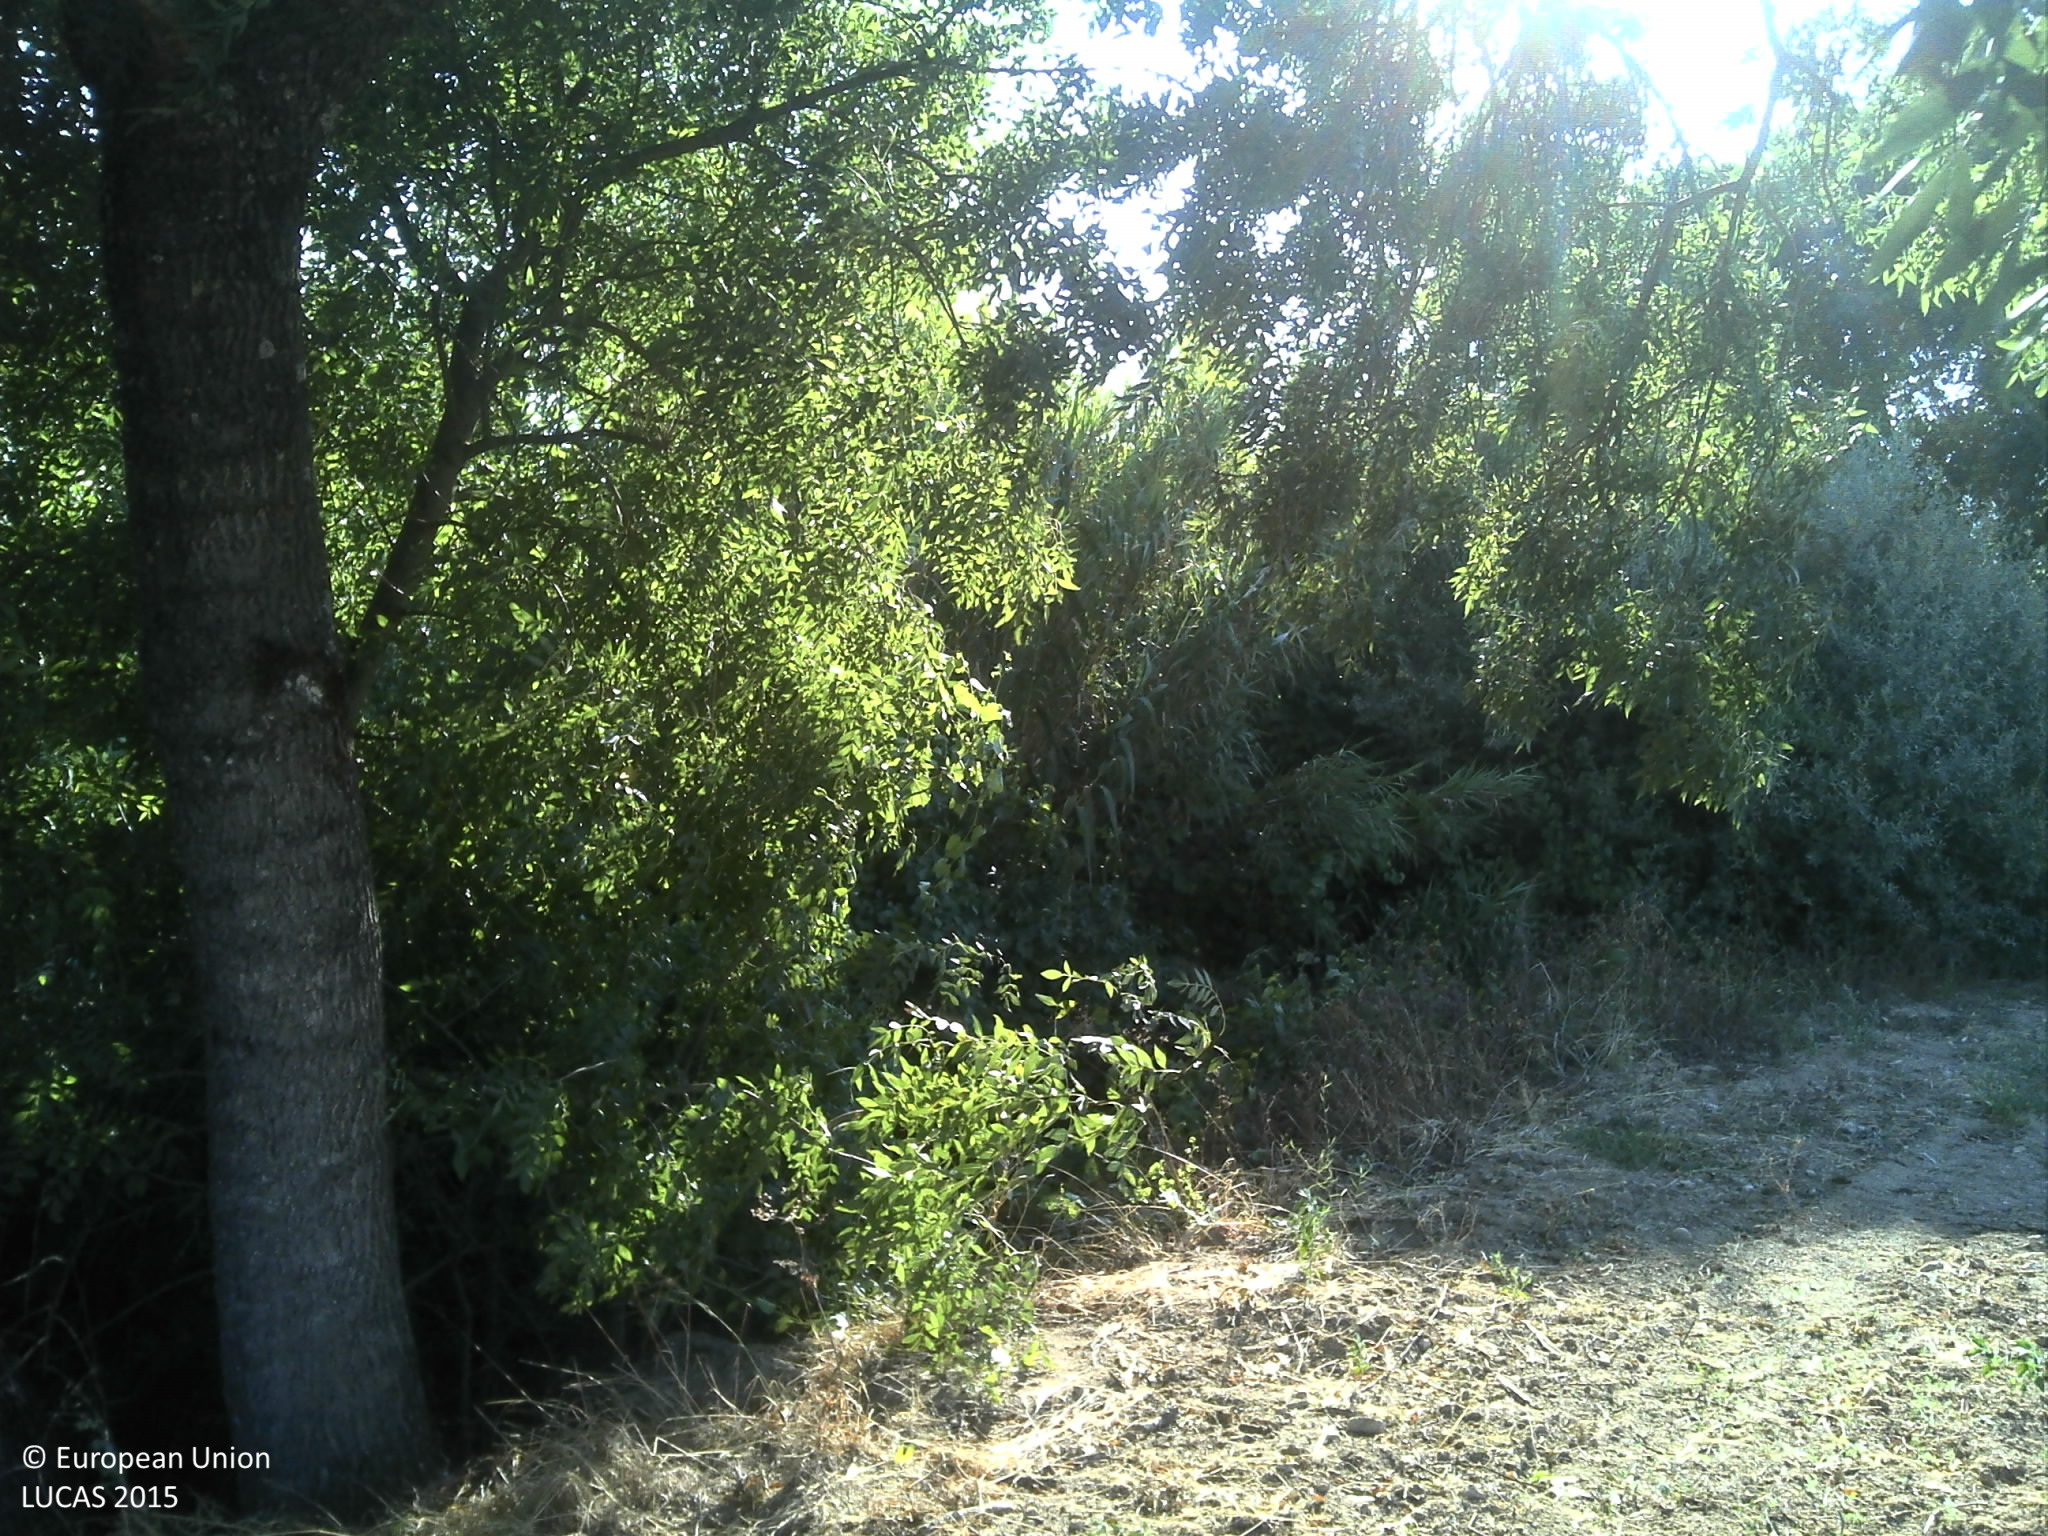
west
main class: Cropland
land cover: Vineyards
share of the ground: 10 - 25 %
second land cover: Other bare soil
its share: > 75 %
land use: Agriculture (excluding fallow land and kitchen gardens)
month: July
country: PT
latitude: 40.3198
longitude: -7.4171
